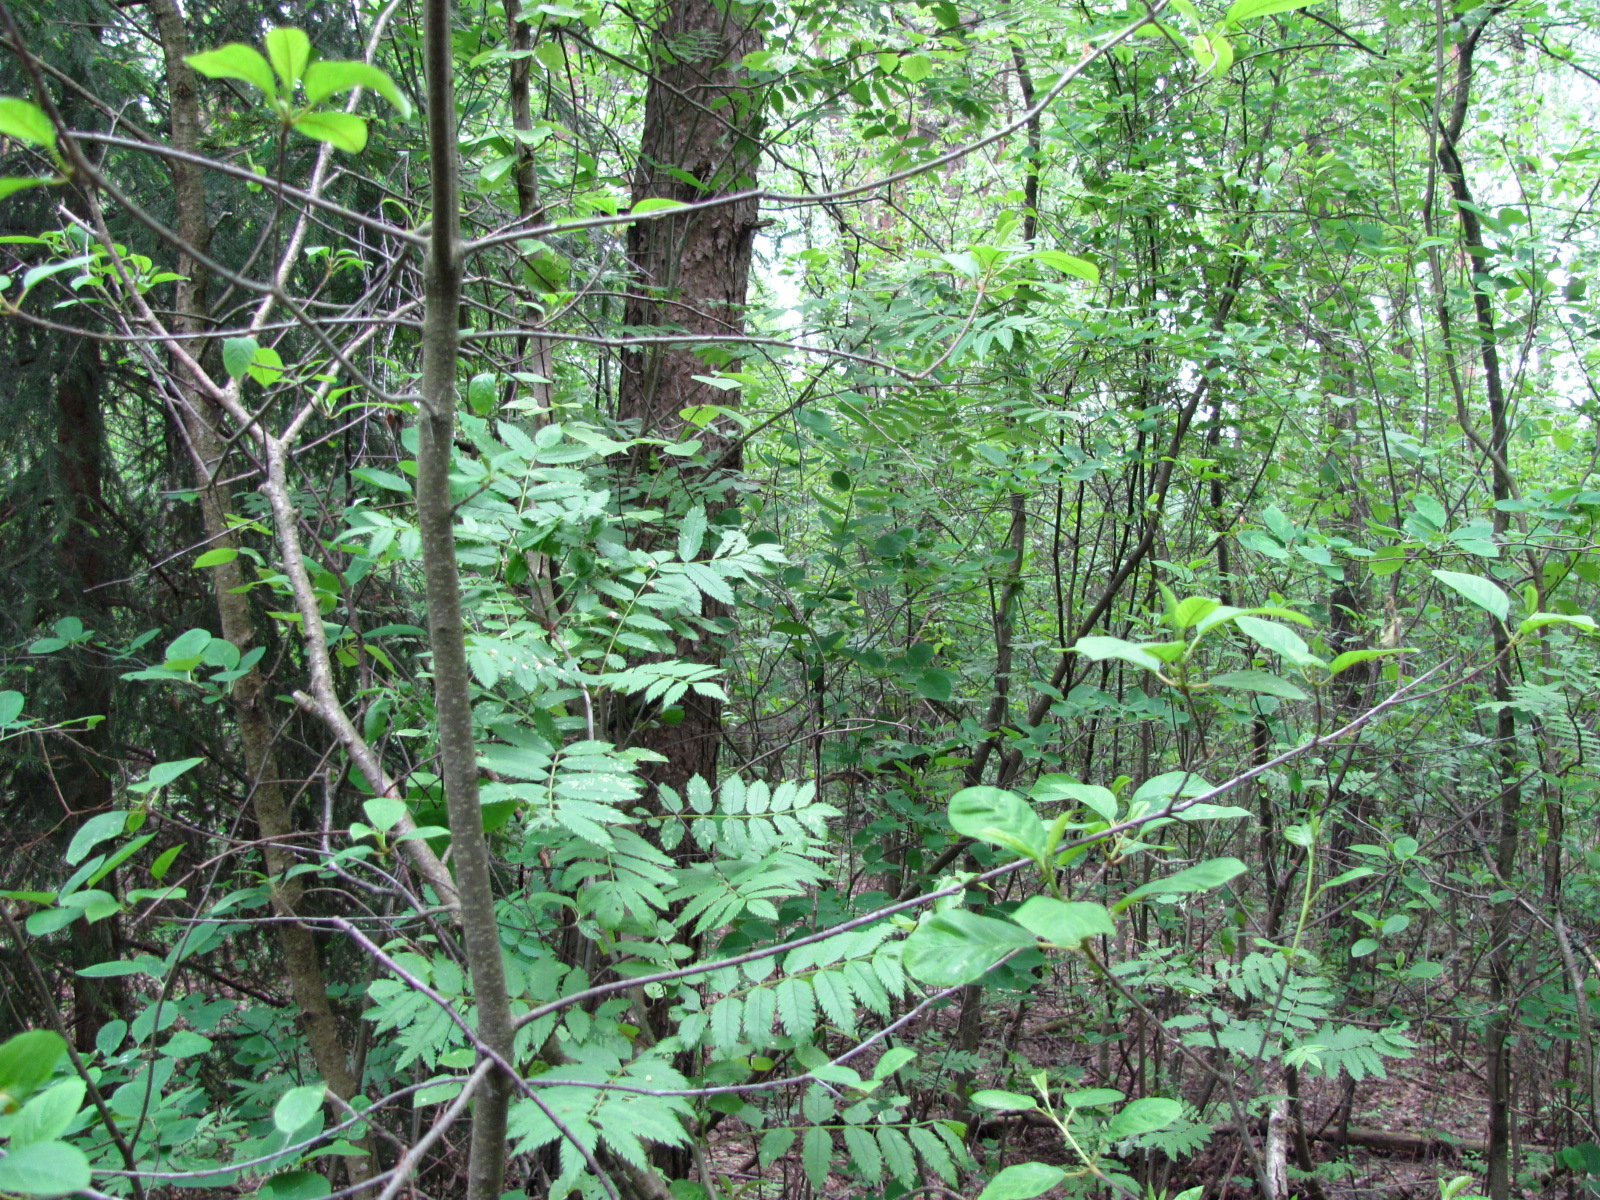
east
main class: Woodland
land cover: Pine dominated mixed woodland
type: hemiboreal forest and nemoral coniferous forest and mixed broadleaved-coniferous forest
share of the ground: > 75 %
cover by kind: broadleaved forest trees 70 %, coniferous forest trees 25 %, lichens and mosses 5 %
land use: Forestry
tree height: > 5 m
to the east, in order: Pine dominated mixed woodland; Broadleaved woodland; Grassland without tree/shrub cover
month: June
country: LV
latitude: 56.8129
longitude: 23.9237
